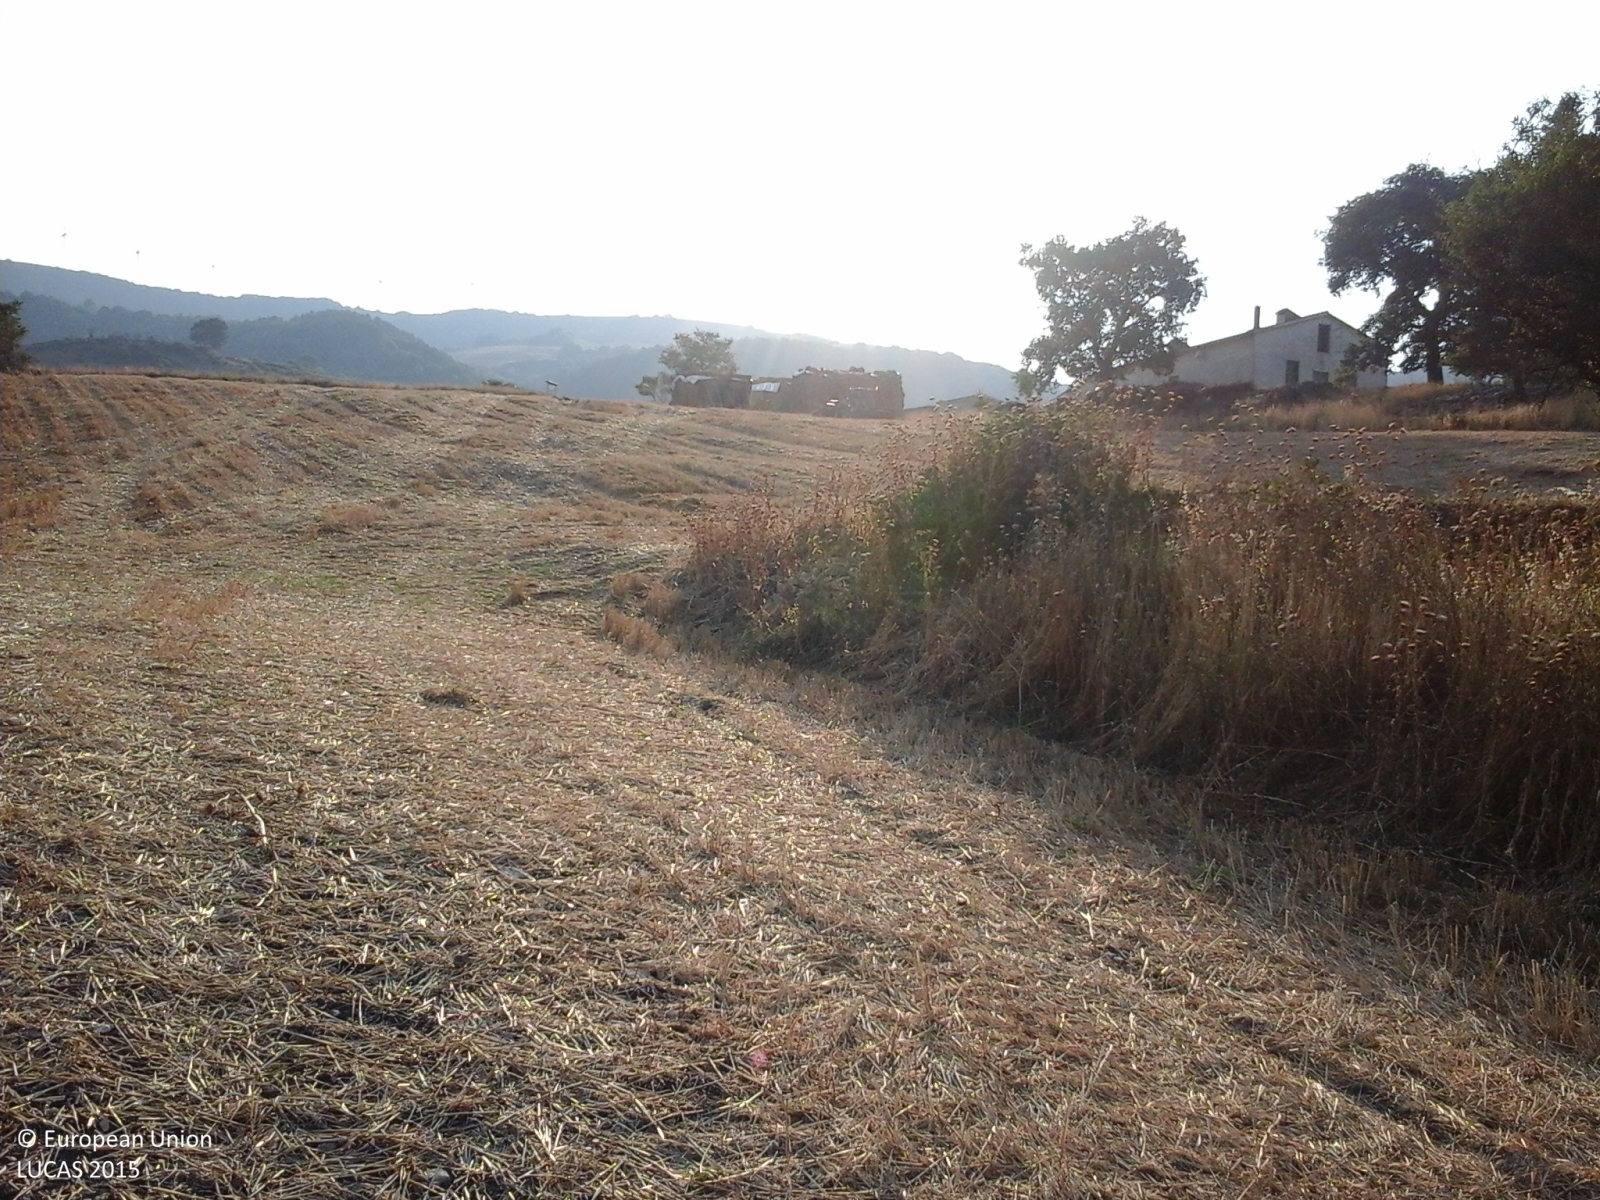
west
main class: Cropland
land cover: Durum wheat
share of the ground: > 75 %
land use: Agriculture (excluding fallow land and kitchen gardens)
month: August
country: IT
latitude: 41.4013
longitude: 15.1376
